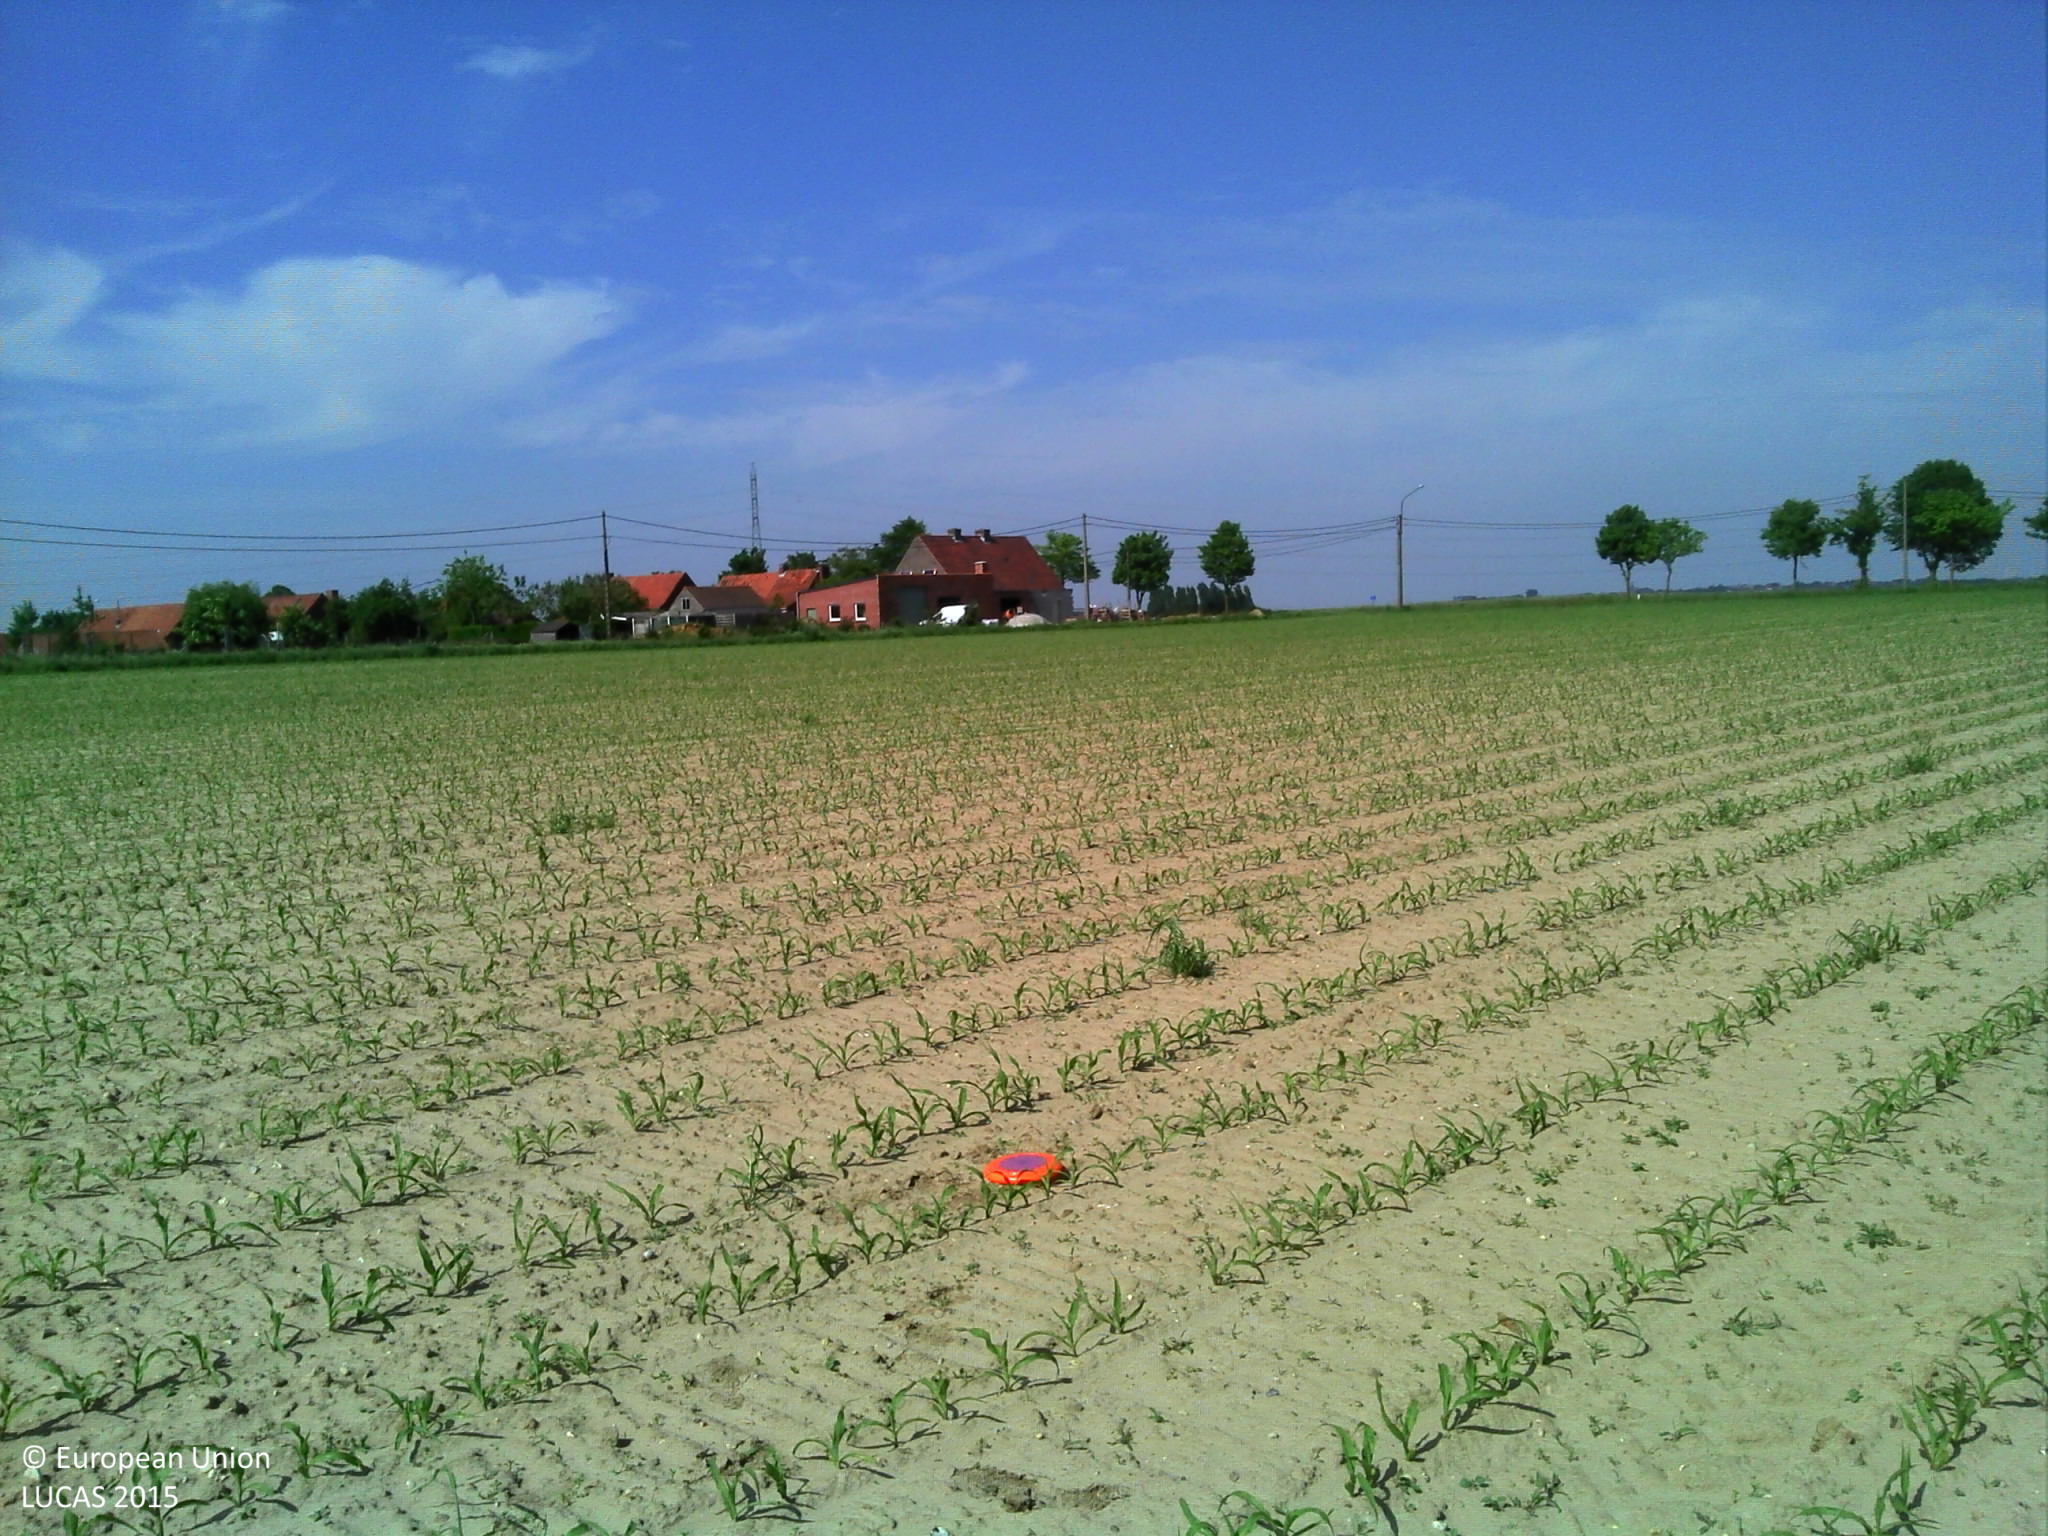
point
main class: Cropland
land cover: Maize
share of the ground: < 10 %
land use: Agriculture (excluding fallow land and kitchen gardens)
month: June
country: BE
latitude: 50.8543
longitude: 3.0152
